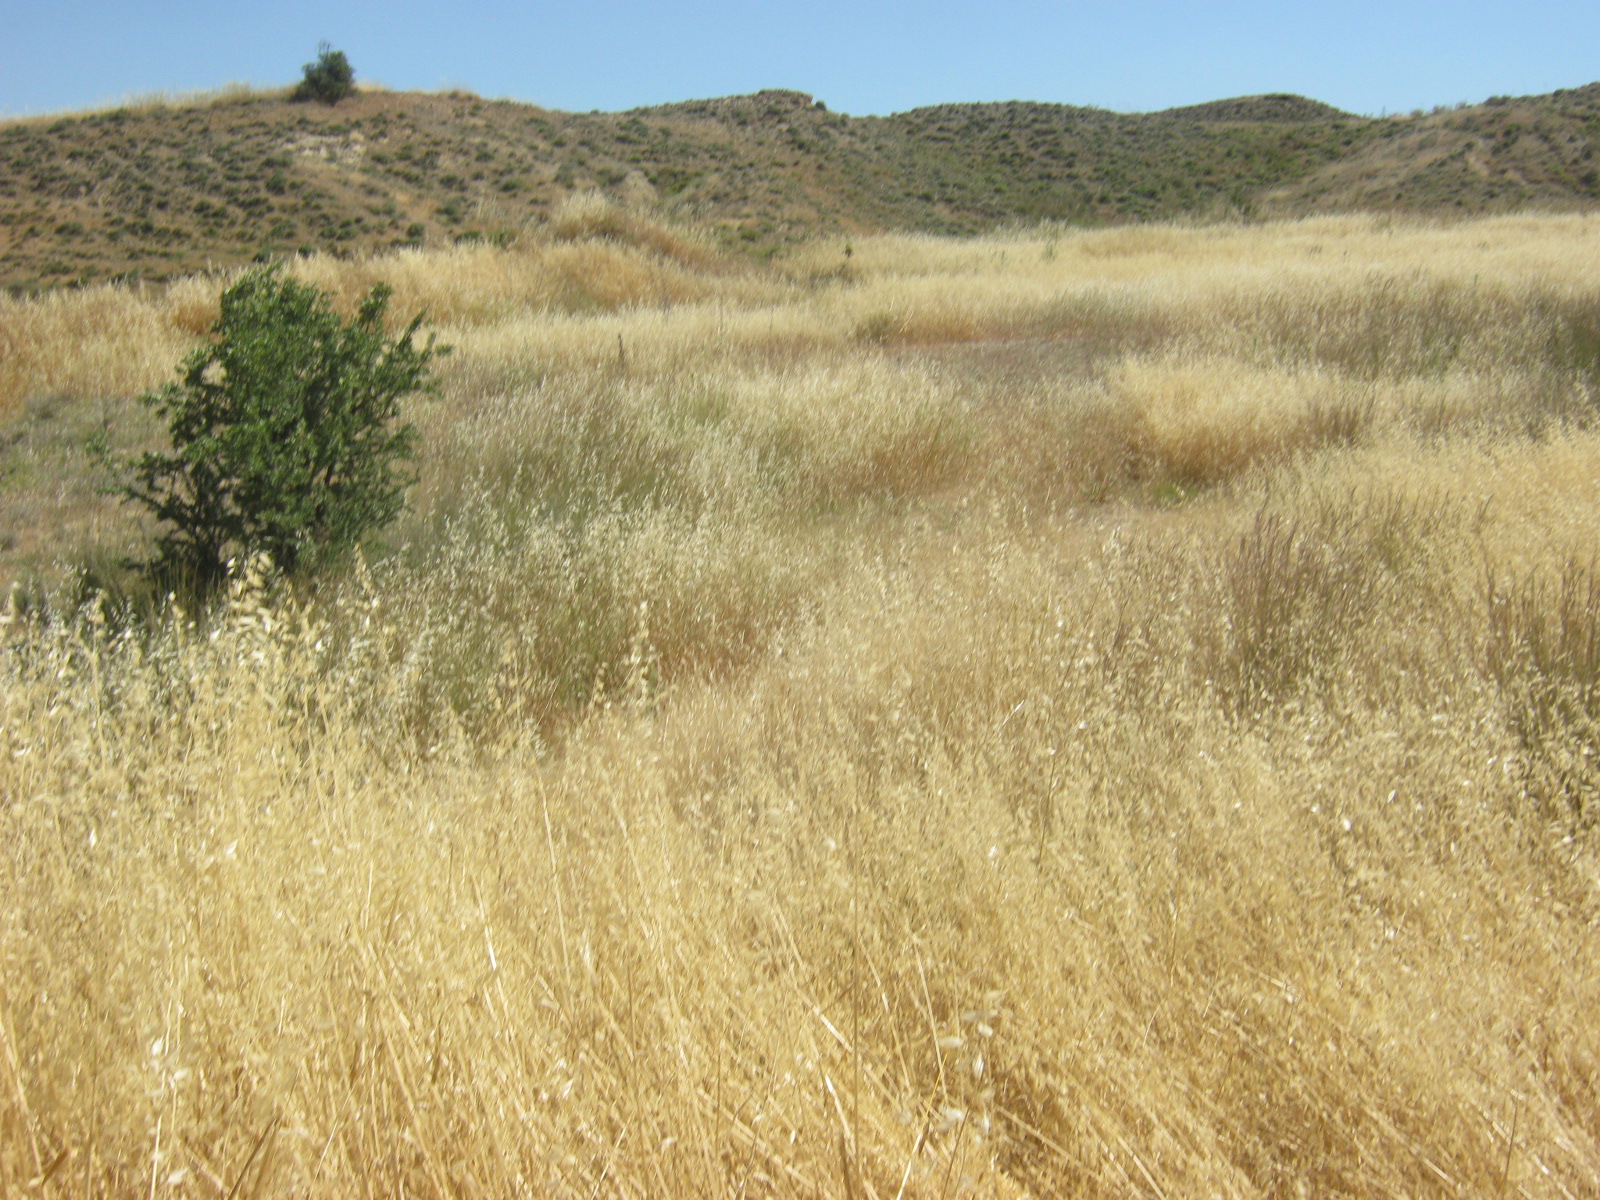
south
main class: Grassland
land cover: Spontaneously vegetated surfaces
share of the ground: > 75 %
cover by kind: herbaceous plants 100 %
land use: Semi-natural and natural areas not in use
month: May
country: CY
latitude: 35.0963
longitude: 33.2107
